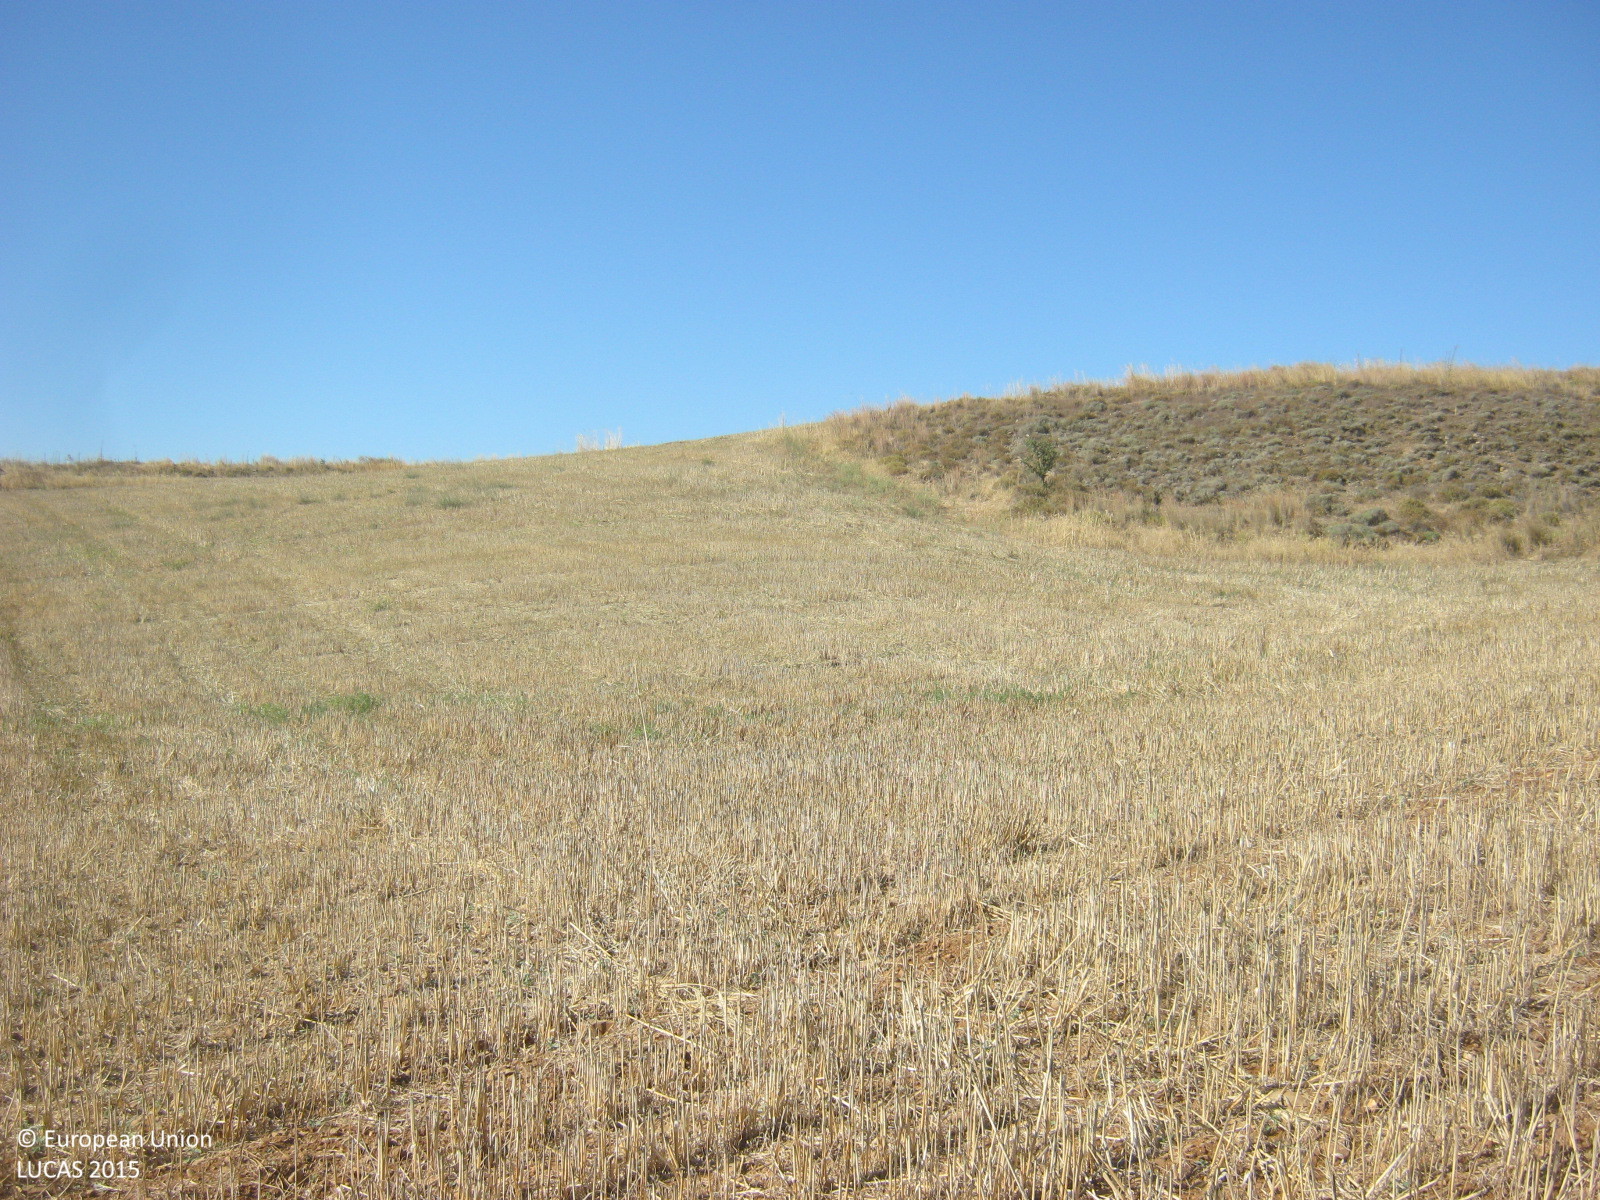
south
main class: Cropland
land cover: Barley
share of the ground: < 10 %
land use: Agriculture (excluding fallow land and kitchen gardens)
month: June
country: CY
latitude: 35.0844
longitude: 33.1839
